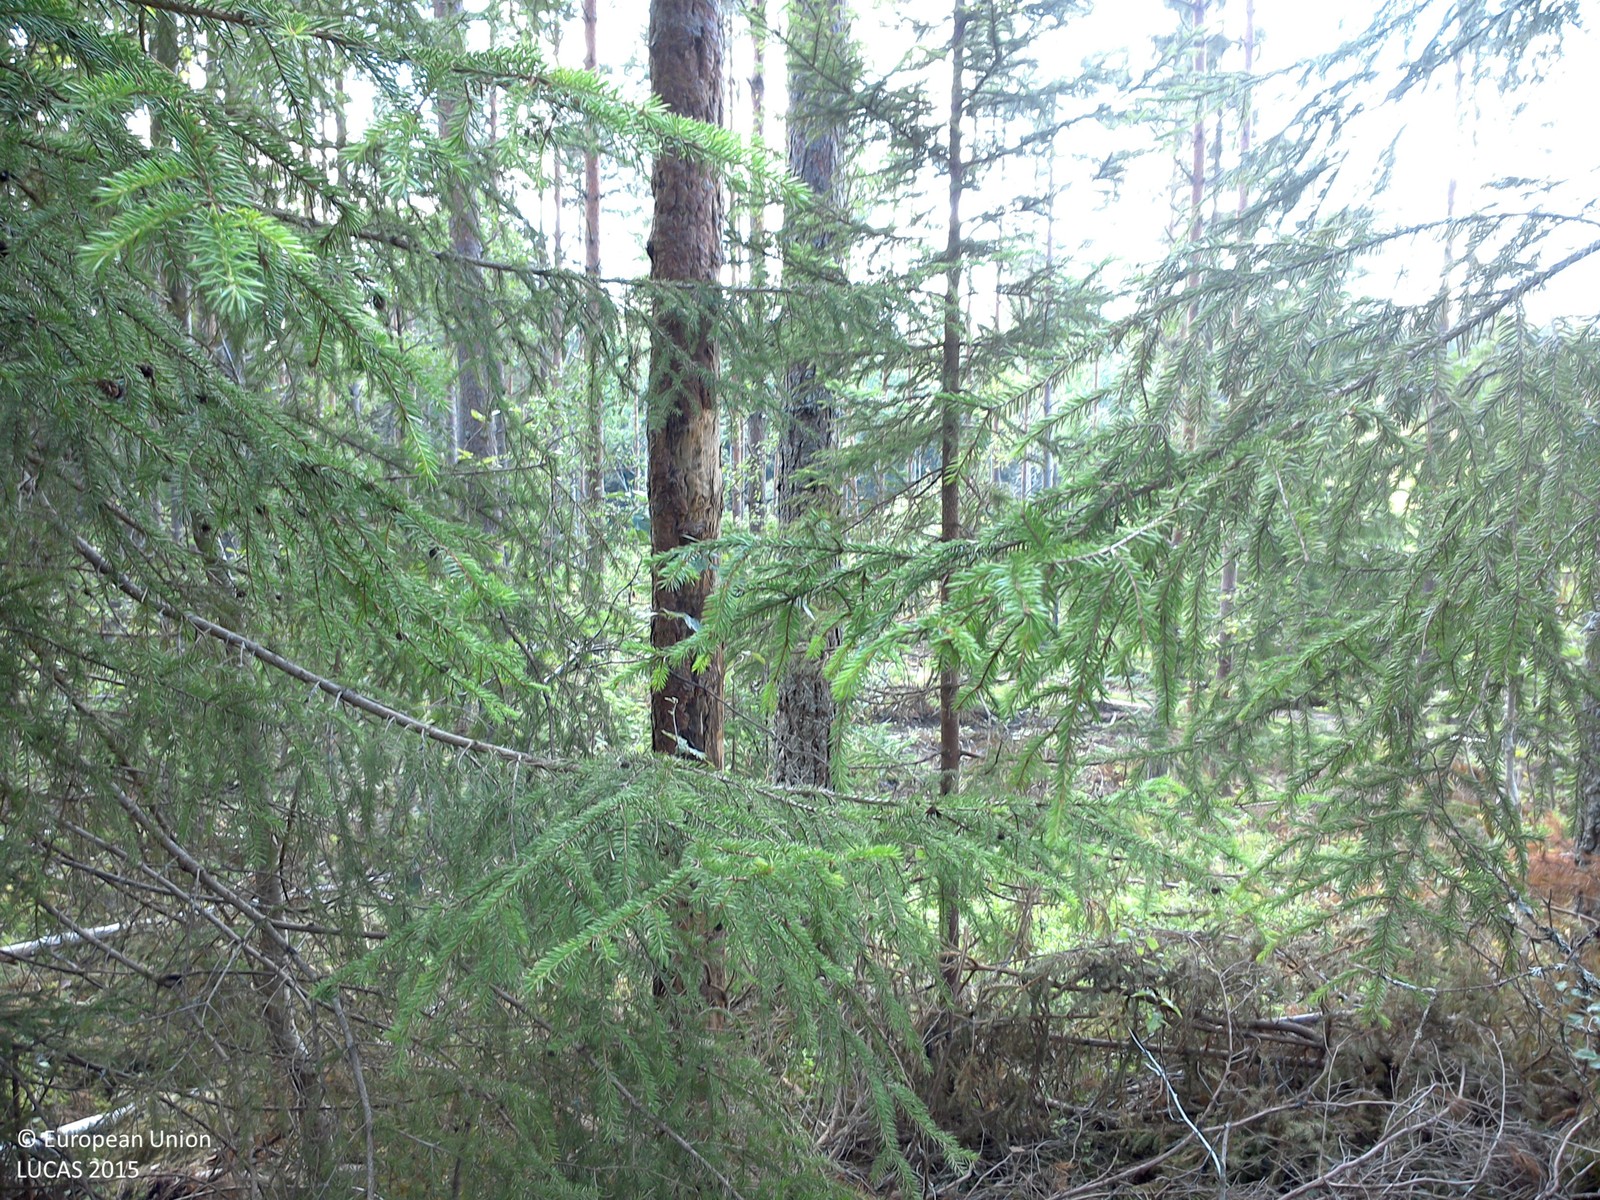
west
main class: Woodland
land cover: Pine dominated coniferous woodland
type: boreal forest
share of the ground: 25 - 50 %
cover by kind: herbaceous plants 65 %, coniferous forest trees 30 %, lichens and mosses 5 %
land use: Forestry
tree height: > 5 m
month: August
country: SE
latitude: 58.1479
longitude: 15.3806
